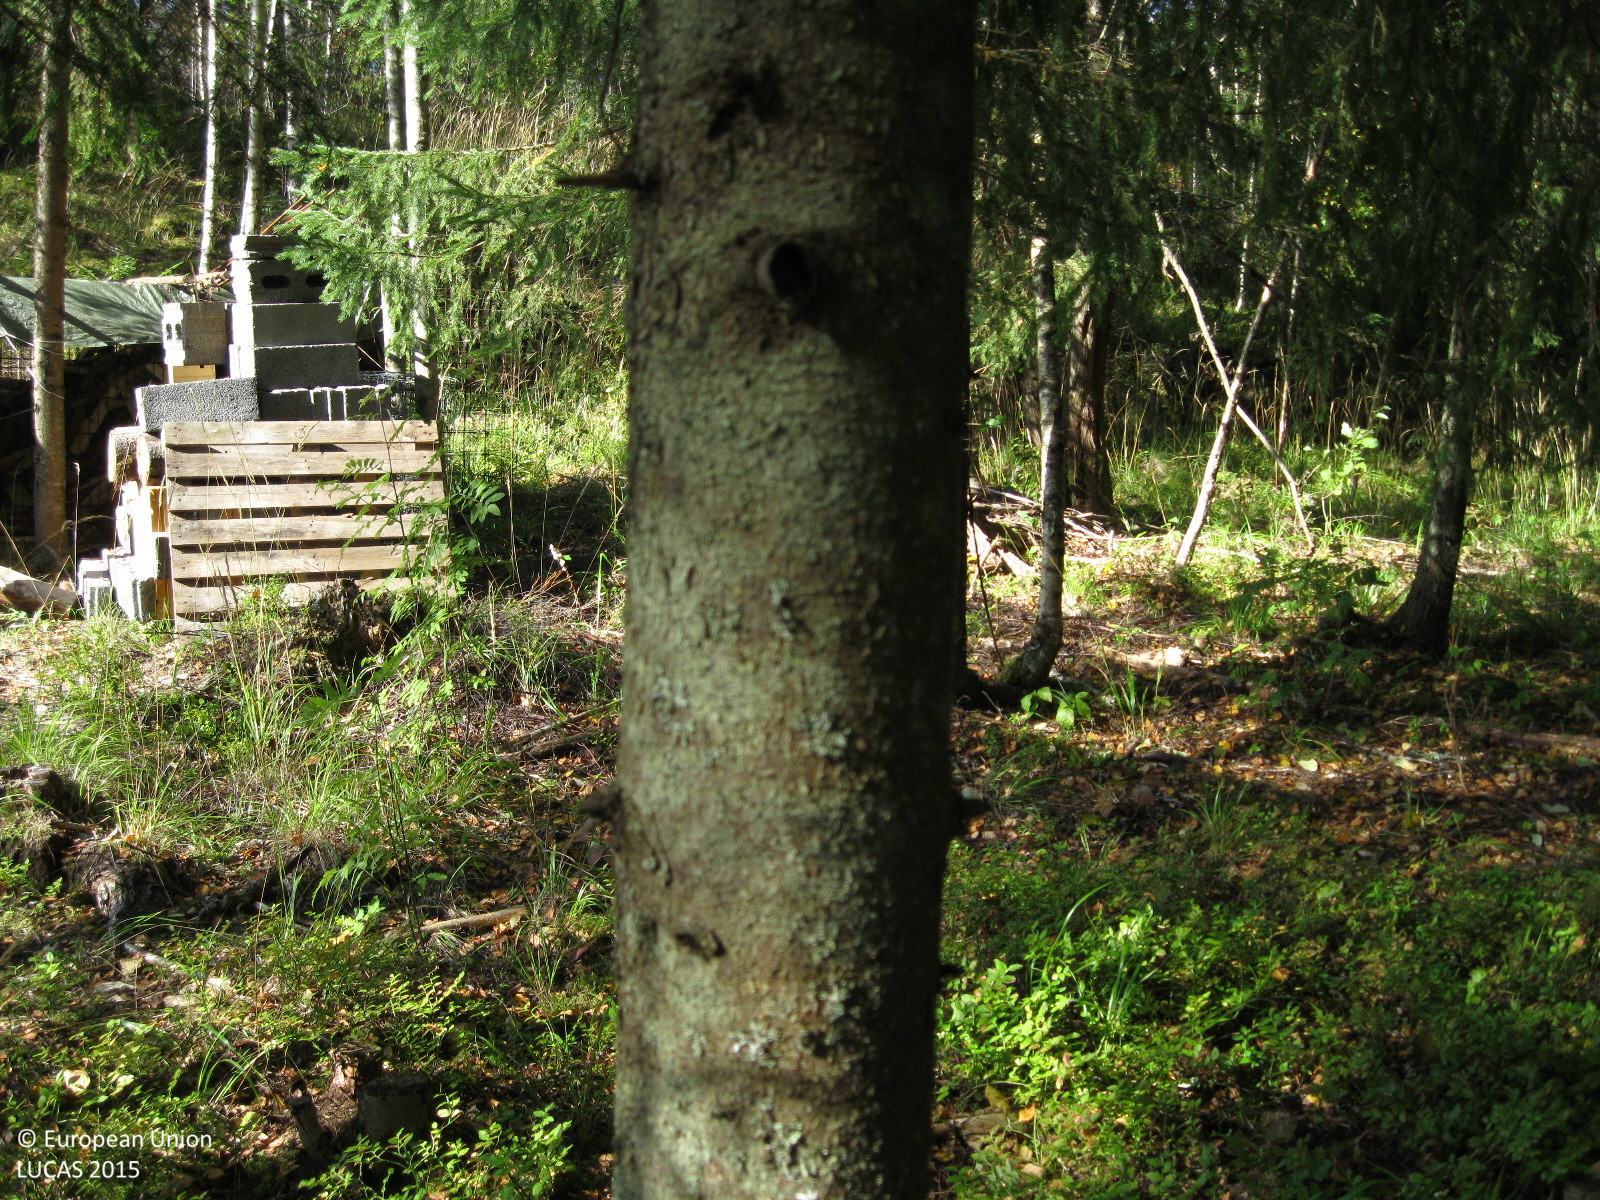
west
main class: Woodland
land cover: Spruce dominated mixed woodland
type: boreal forest
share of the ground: > 75 %
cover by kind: coniferous forest trees 45 %, broadleaved forest trees 35 %, shrubs 10 %, herbaceous plants 5 %, lichens and mosses 5 %
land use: Forestry
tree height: > 5 m
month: September
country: FI
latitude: 60.8798
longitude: 25.5083
